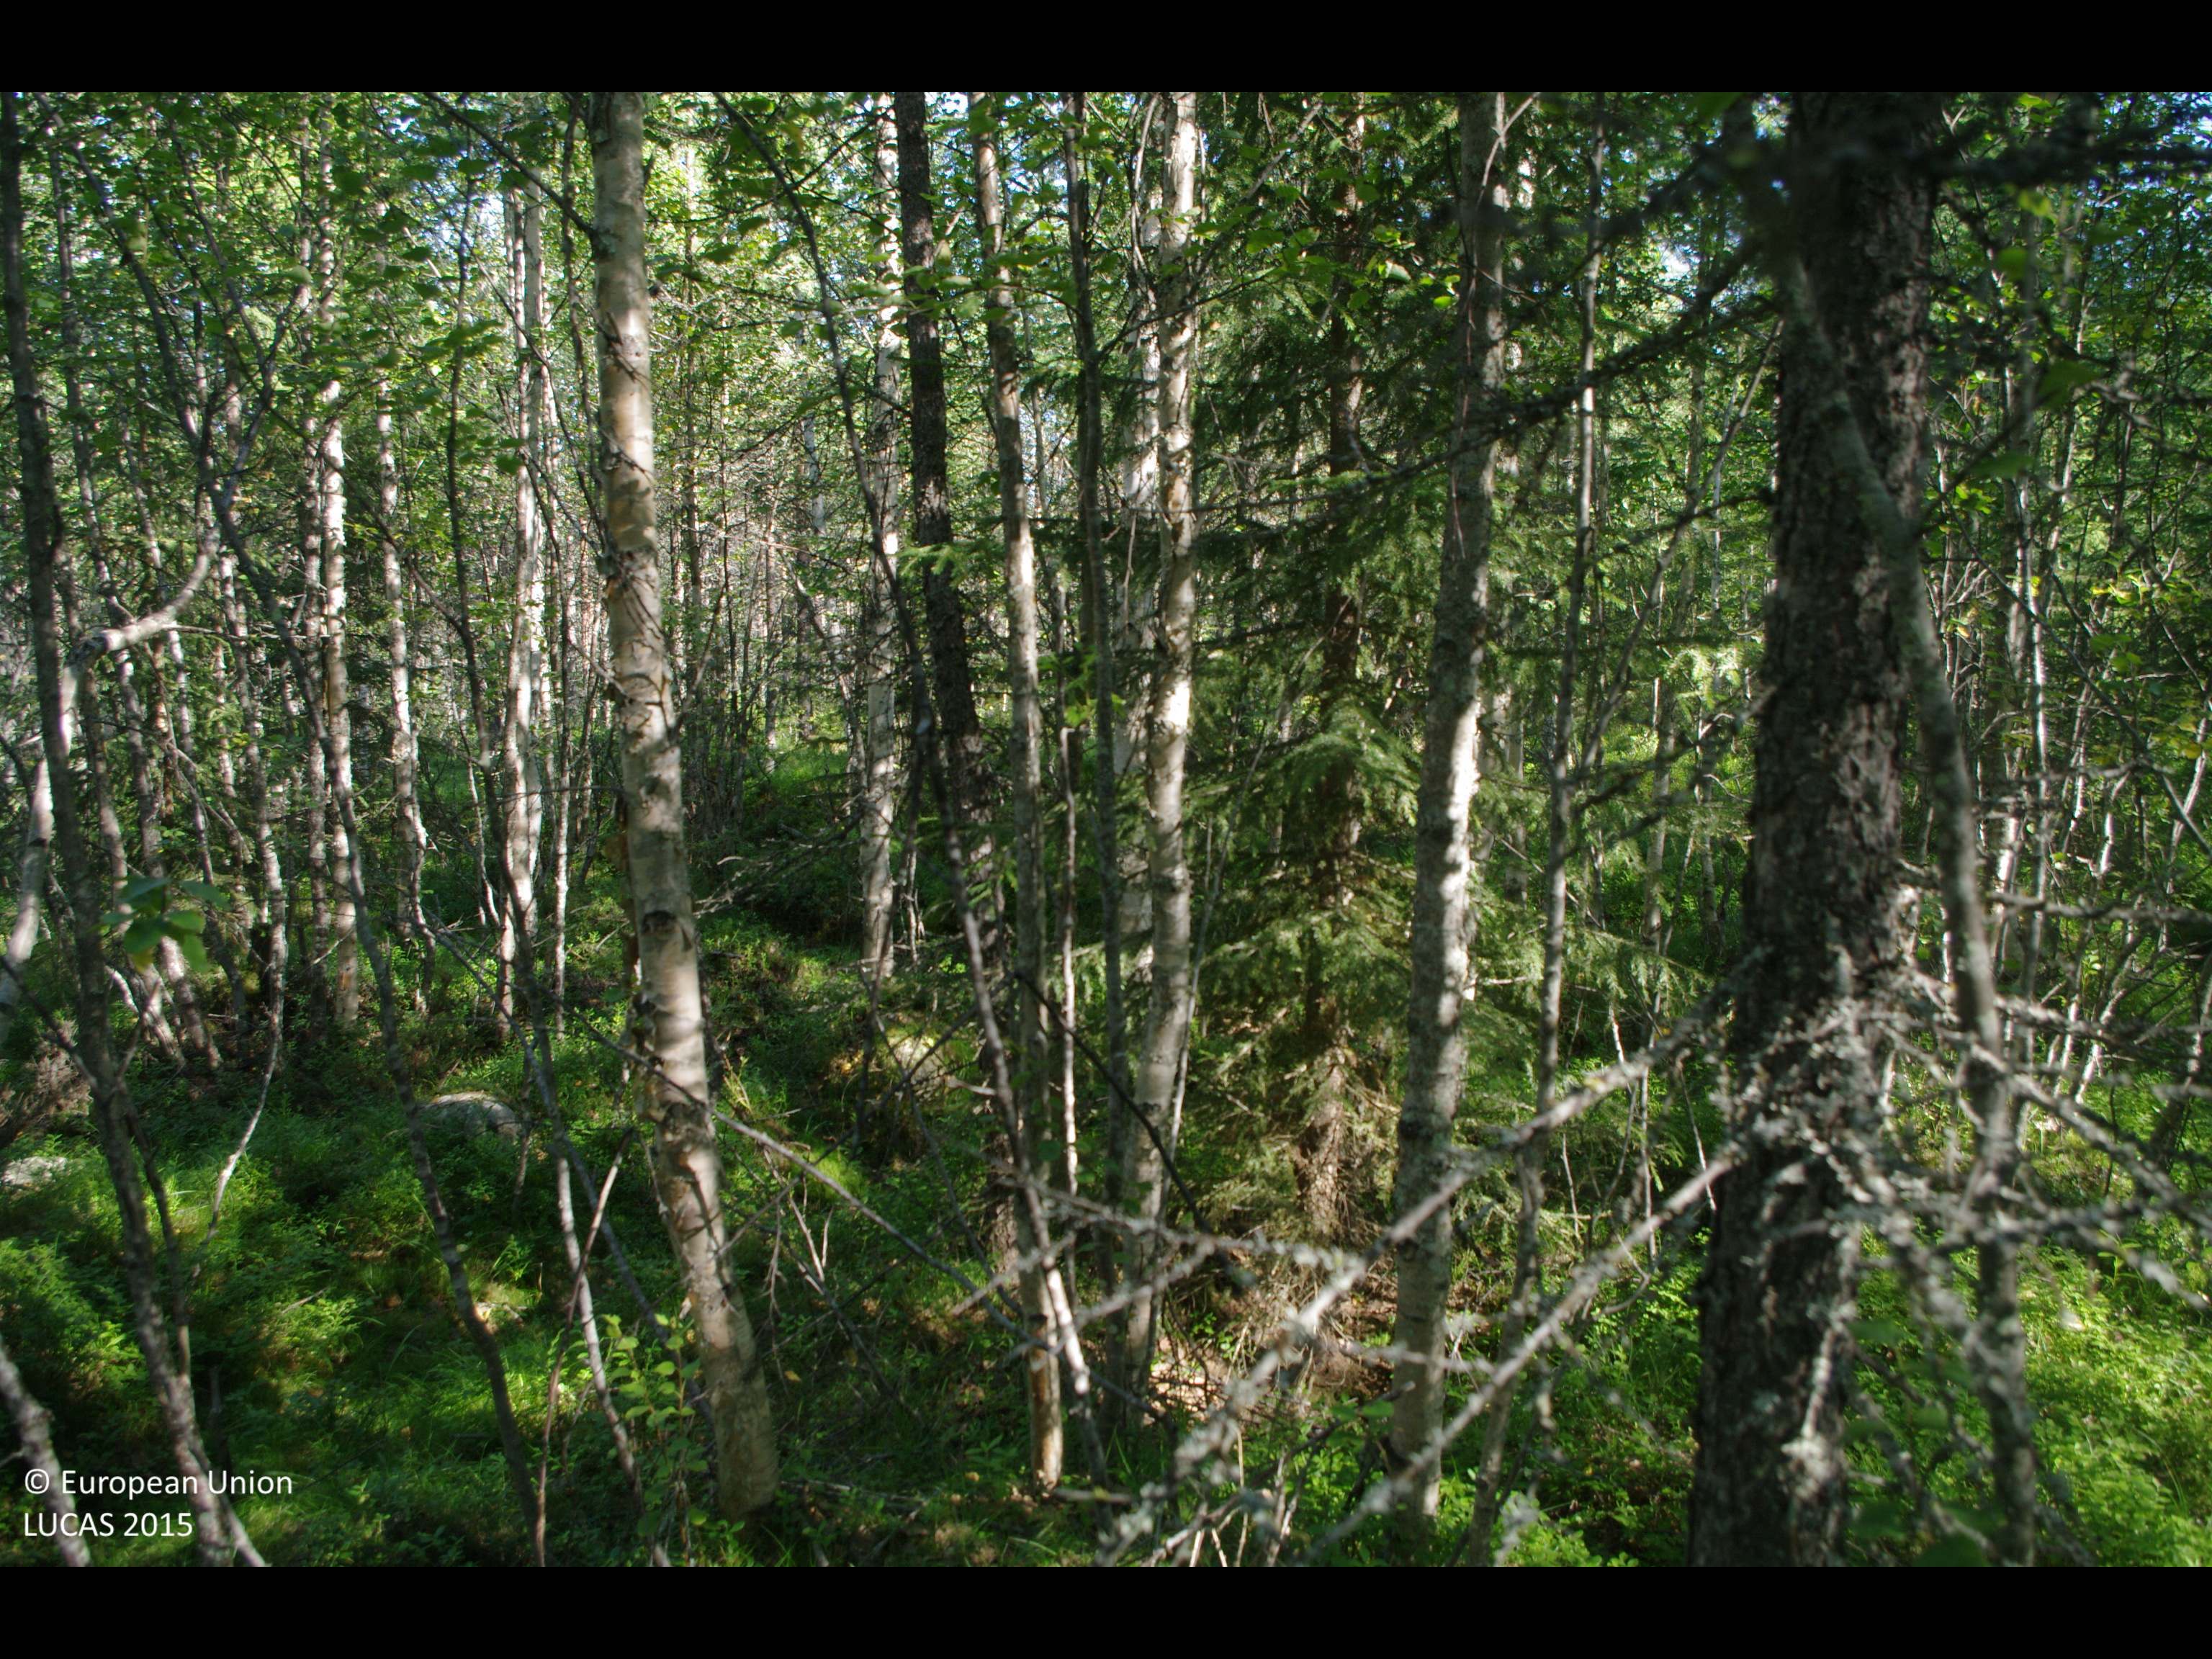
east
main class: Woodland
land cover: Other mixed woodland
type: boreal forest
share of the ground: > 75 %
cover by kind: broadleaved forest trees 50 %, coniferous forest trees 30 %, herbaceous plants 10 %, shrubs 5 %, lichens and mosses 5 %
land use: Forestry
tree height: > 5 m
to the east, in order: Other mixed woodland; Ditches and canals; Pine dominated mixed woodland; Ditches and canals; Pine dominated mixed woodland; Ditches and canals; Pine dominated mixed woodland; Ditches and canals; Pine dominated mixed woodland; Ditches and canals; Pine dominated mixed woodland; Shruby margins; Ditches and canals; Grass margins; Paved roads, cycling and walking lanes; Spontaneously vegetated surfaces; Ditches and canals; Abandoned hedges; Ditches and canals; Spontaneously vegetated surfaces; Spruce dominated coniferous woodland; Ditches and canals; Pine dominated mixed woodland; Ditches and canals; Pine dominated mixed woodland; Ditches and canals; Pine dominated mixed woodland; Ditches and canals; Pine dominated mixed woodland; Ditches and canals; Pine dominated mixed woodland; Ditches and canals; Pine dominated mixed woodland
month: August
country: FI
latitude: 65.6544
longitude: 28.1254
